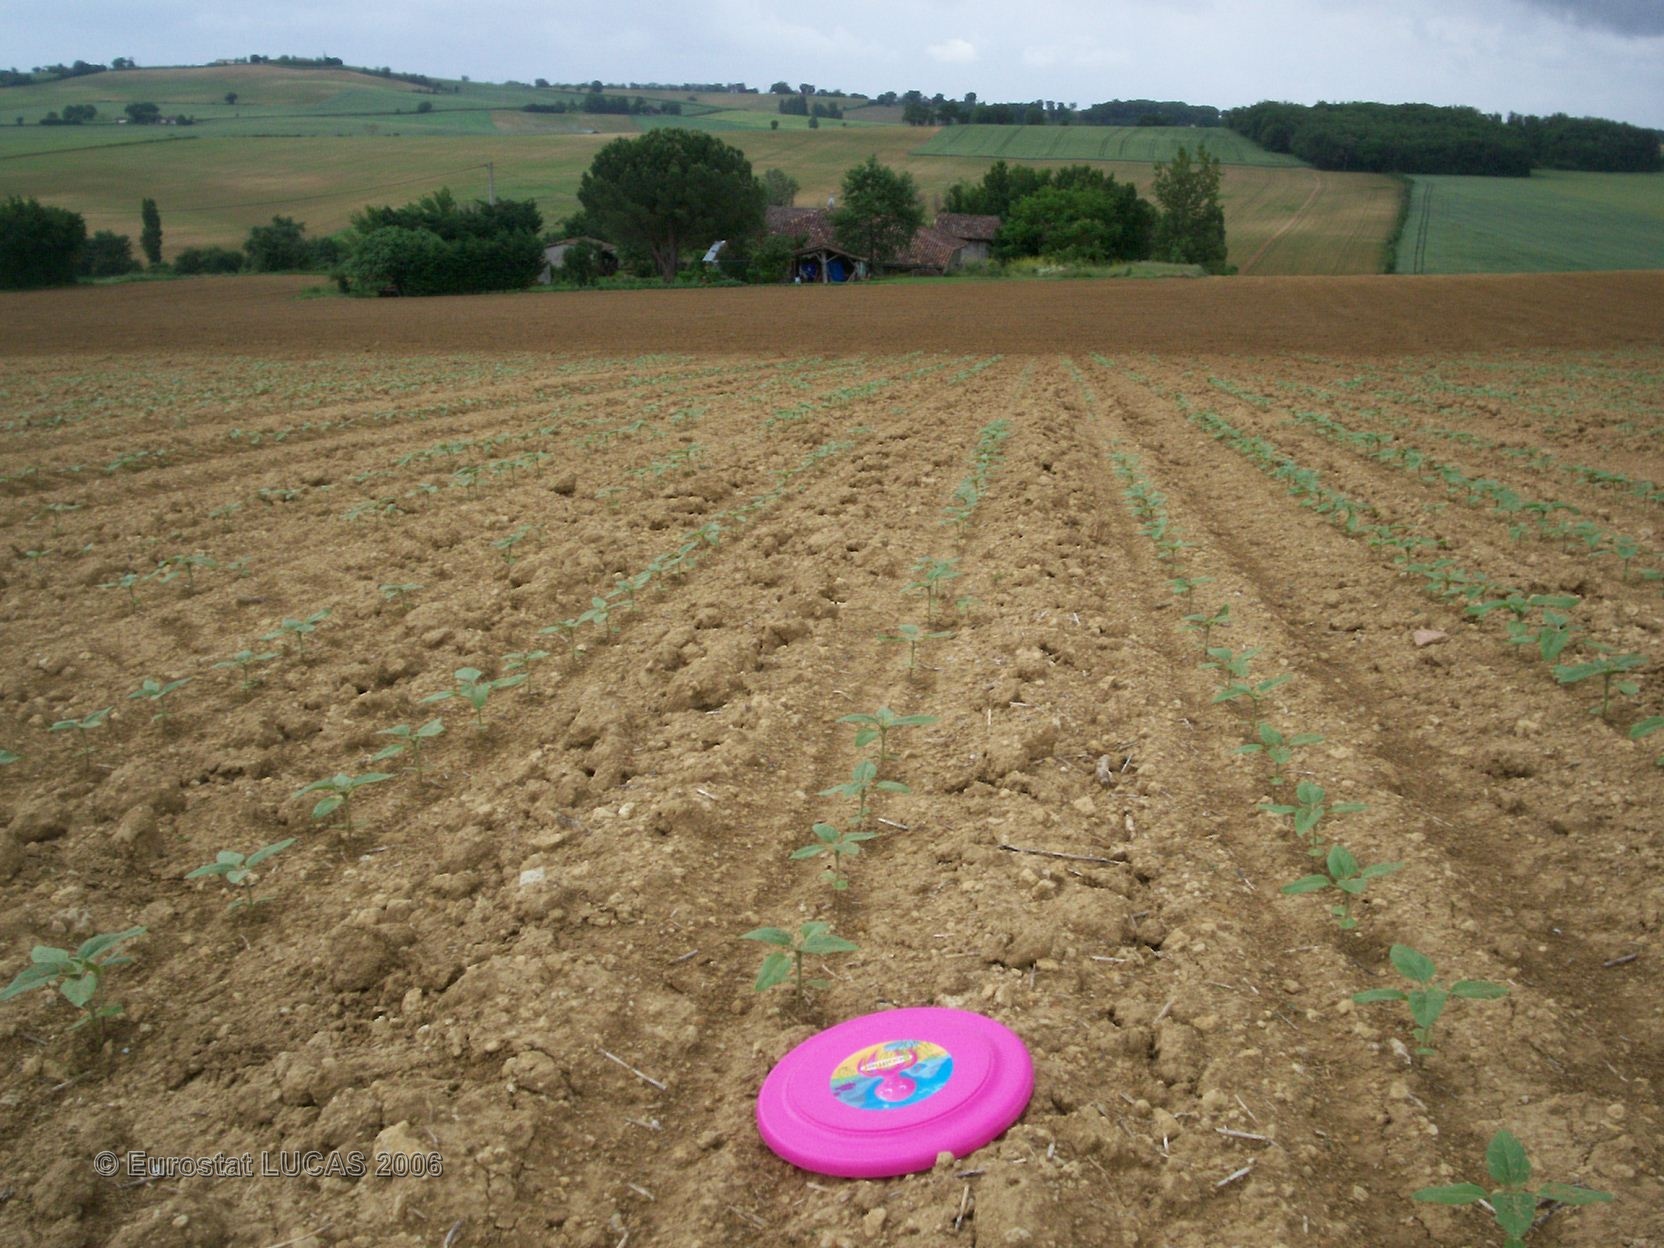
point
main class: Cropland
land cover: Soya
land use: Agriculture (excluding fallow land and kitchen gardens)
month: May
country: FR
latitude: 43.5755
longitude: 0.9732
